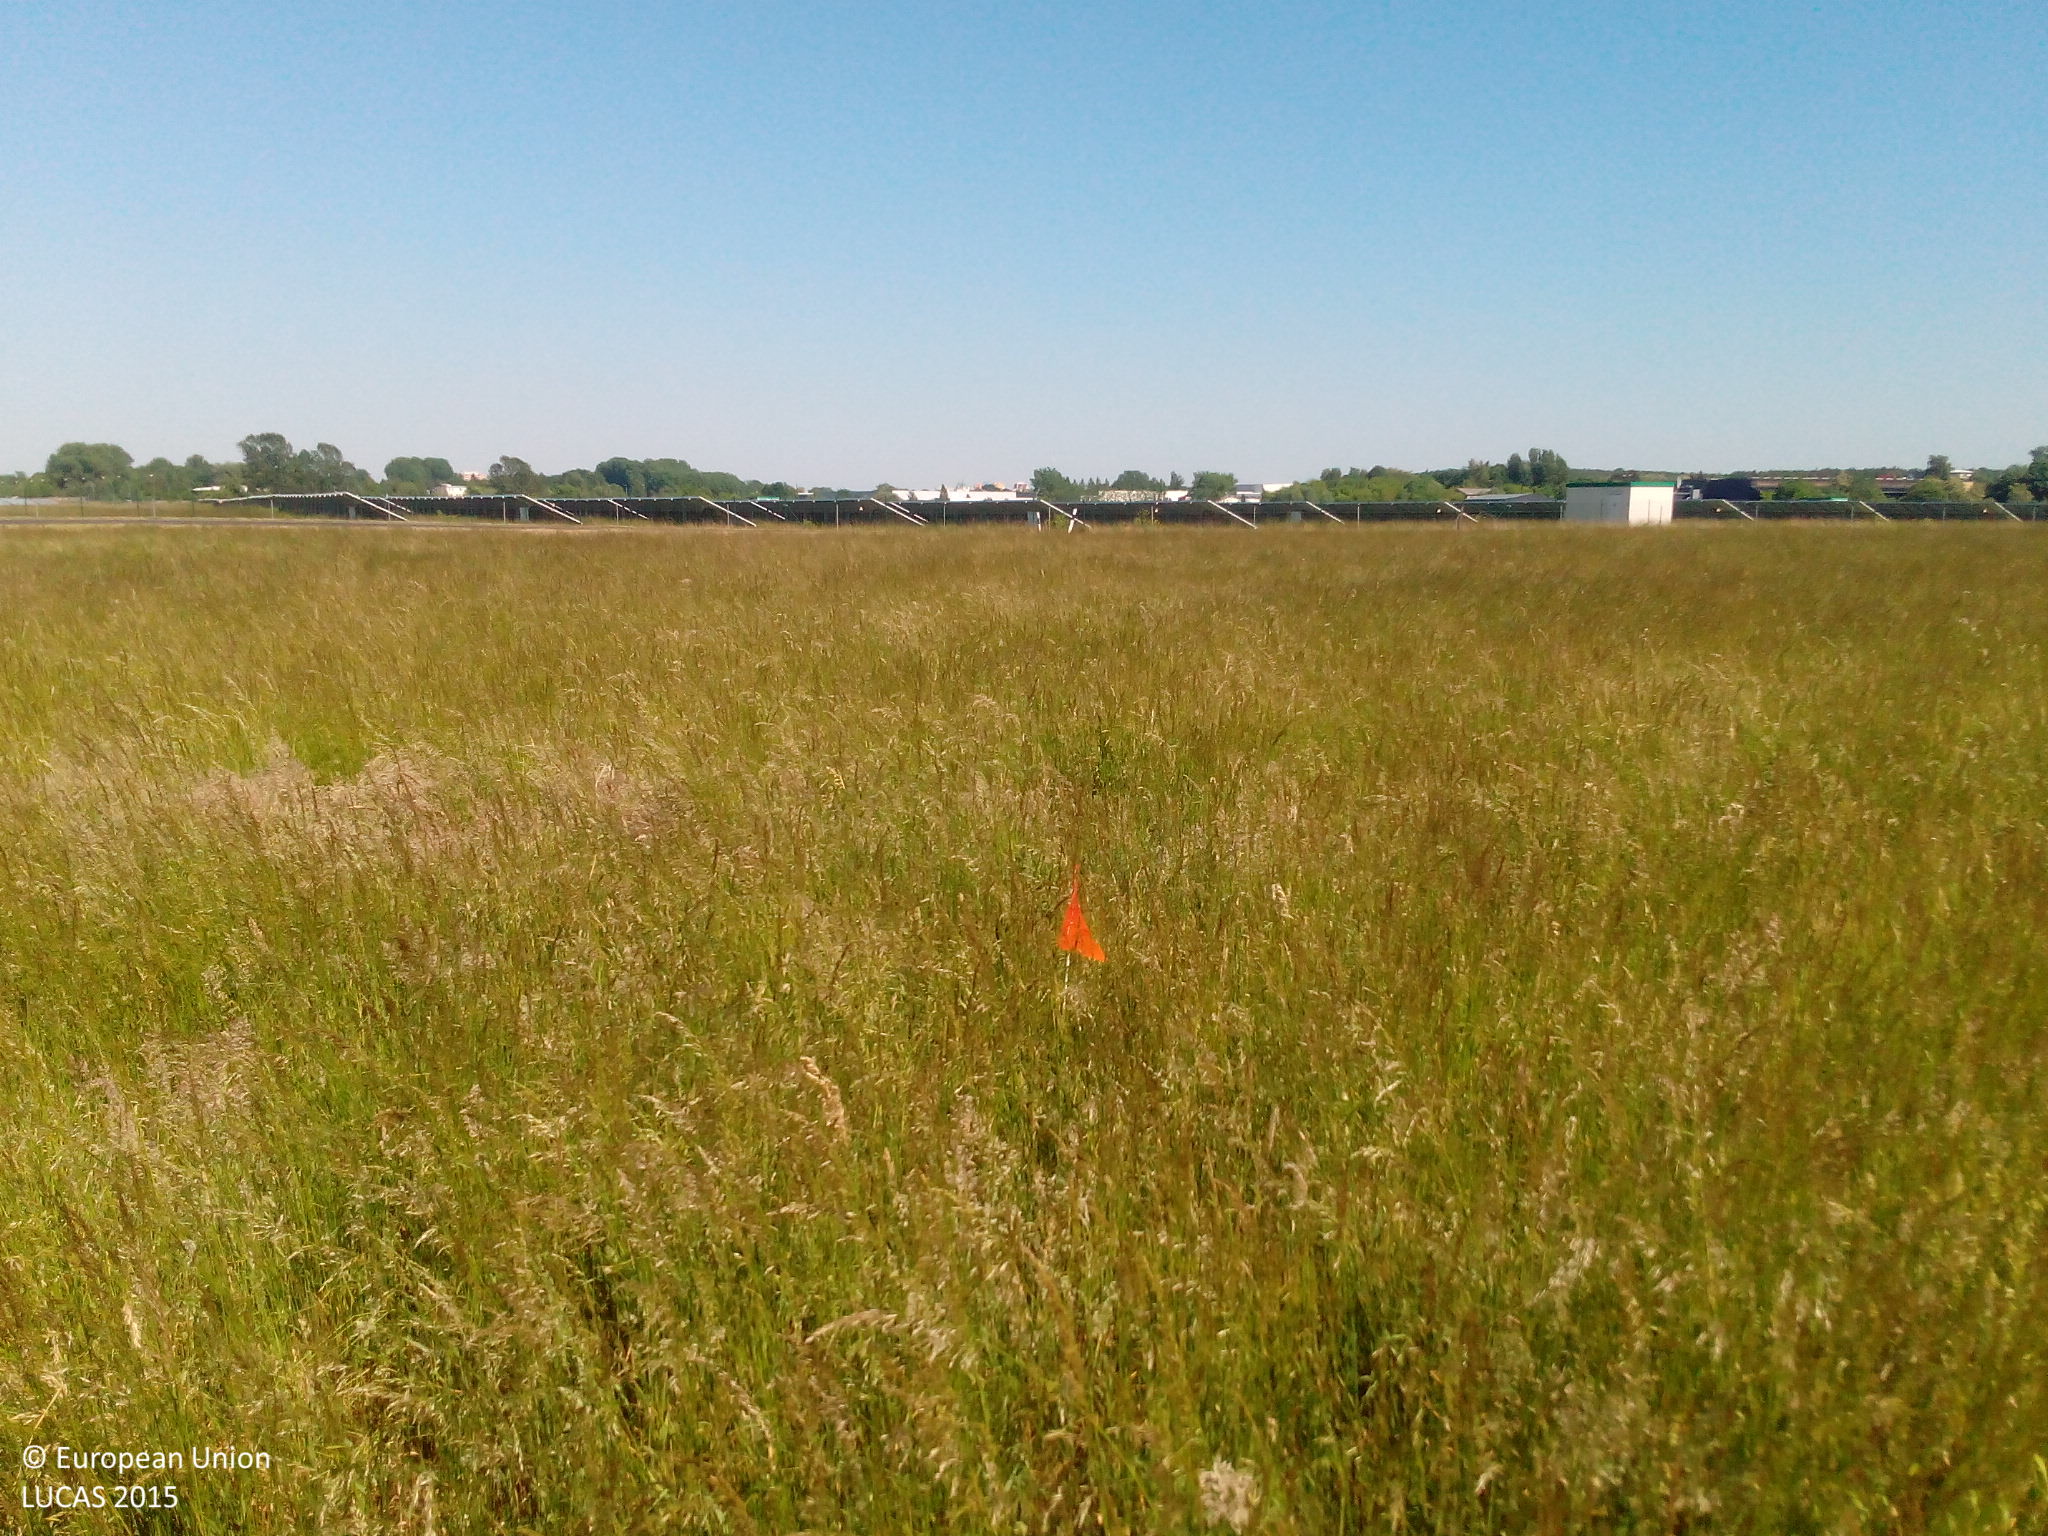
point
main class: Grassland
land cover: Grassland without tree/shrub cover
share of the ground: > 75 %
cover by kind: herbaceous plants 100 %
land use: Agriculture (excluding fallow land and kitchen gardens)
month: June
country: DE
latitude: 52.5346
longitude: 13.1105
